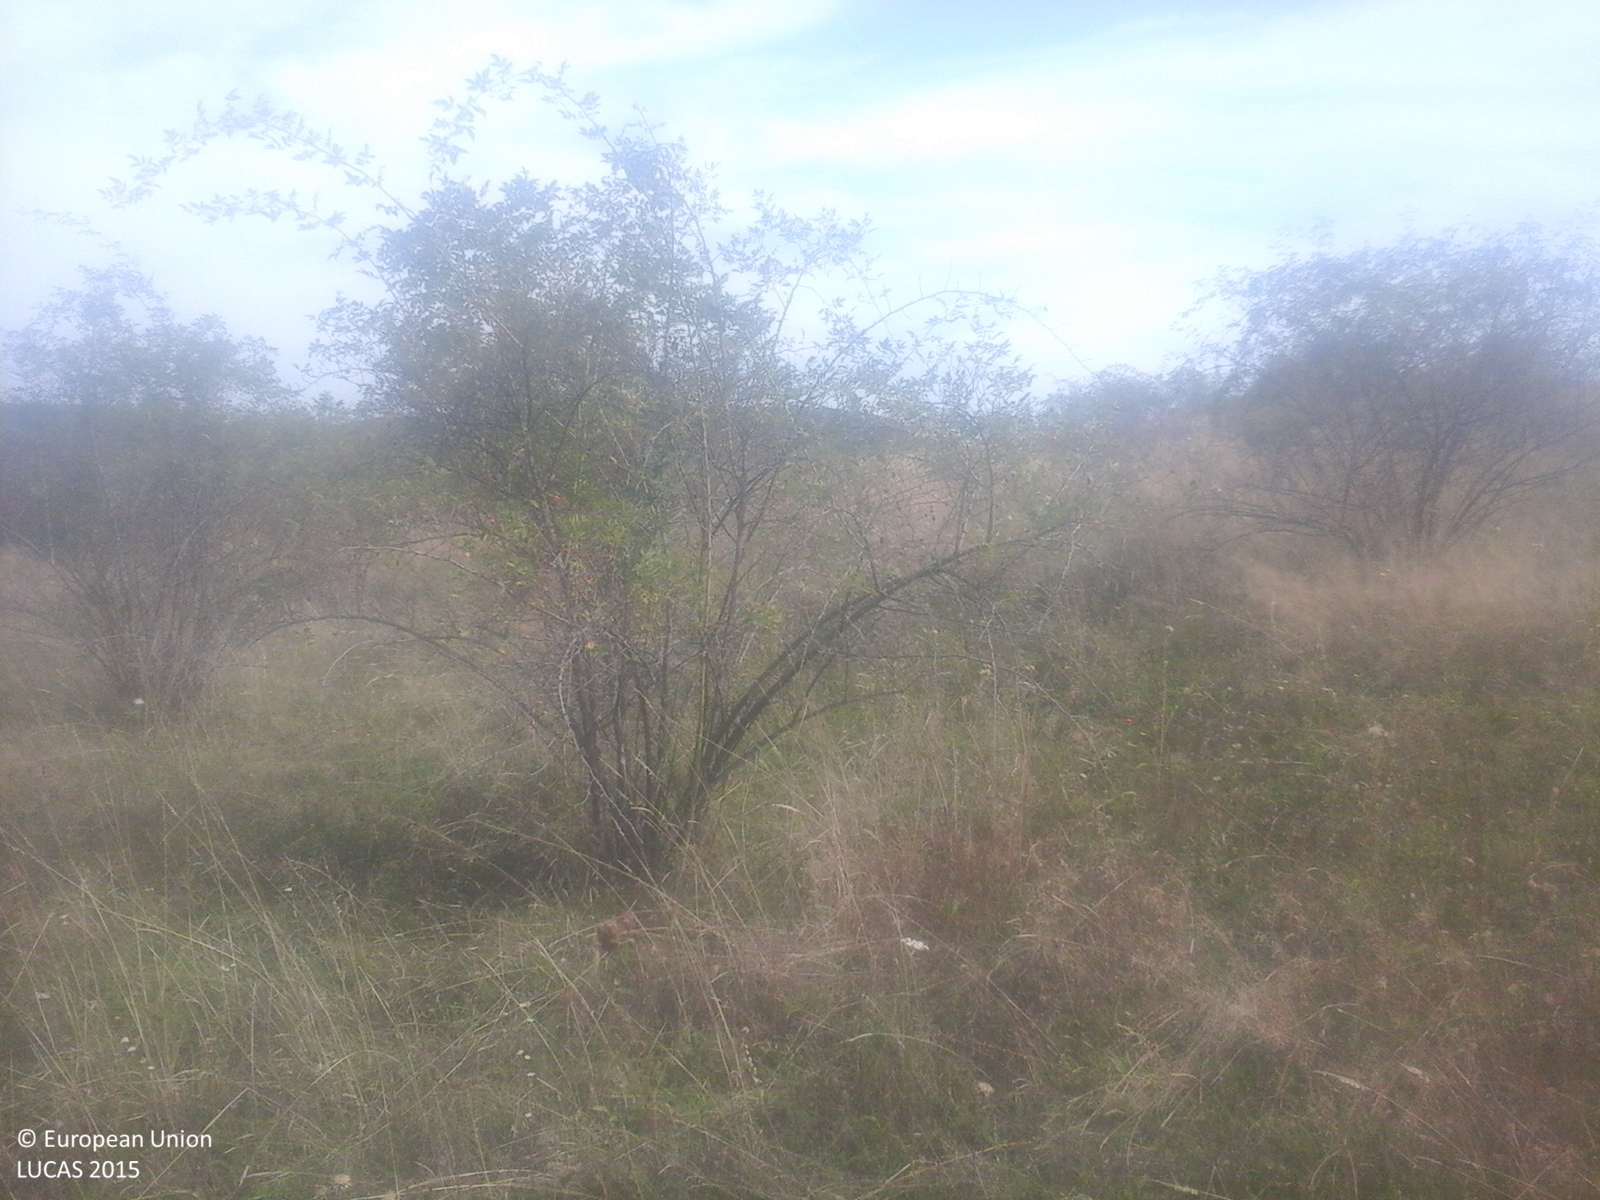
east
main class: Shrubland
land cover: Shrubland without tree cover
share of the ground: > 75 %
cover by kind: shrubs 60 %, herbaceous plants 40 %
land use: Fallow land
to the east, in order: Shrubland without tree cover; Shrubland with sparse tree cover
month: September
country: RO
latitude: 47.0805
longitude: 23.6265
